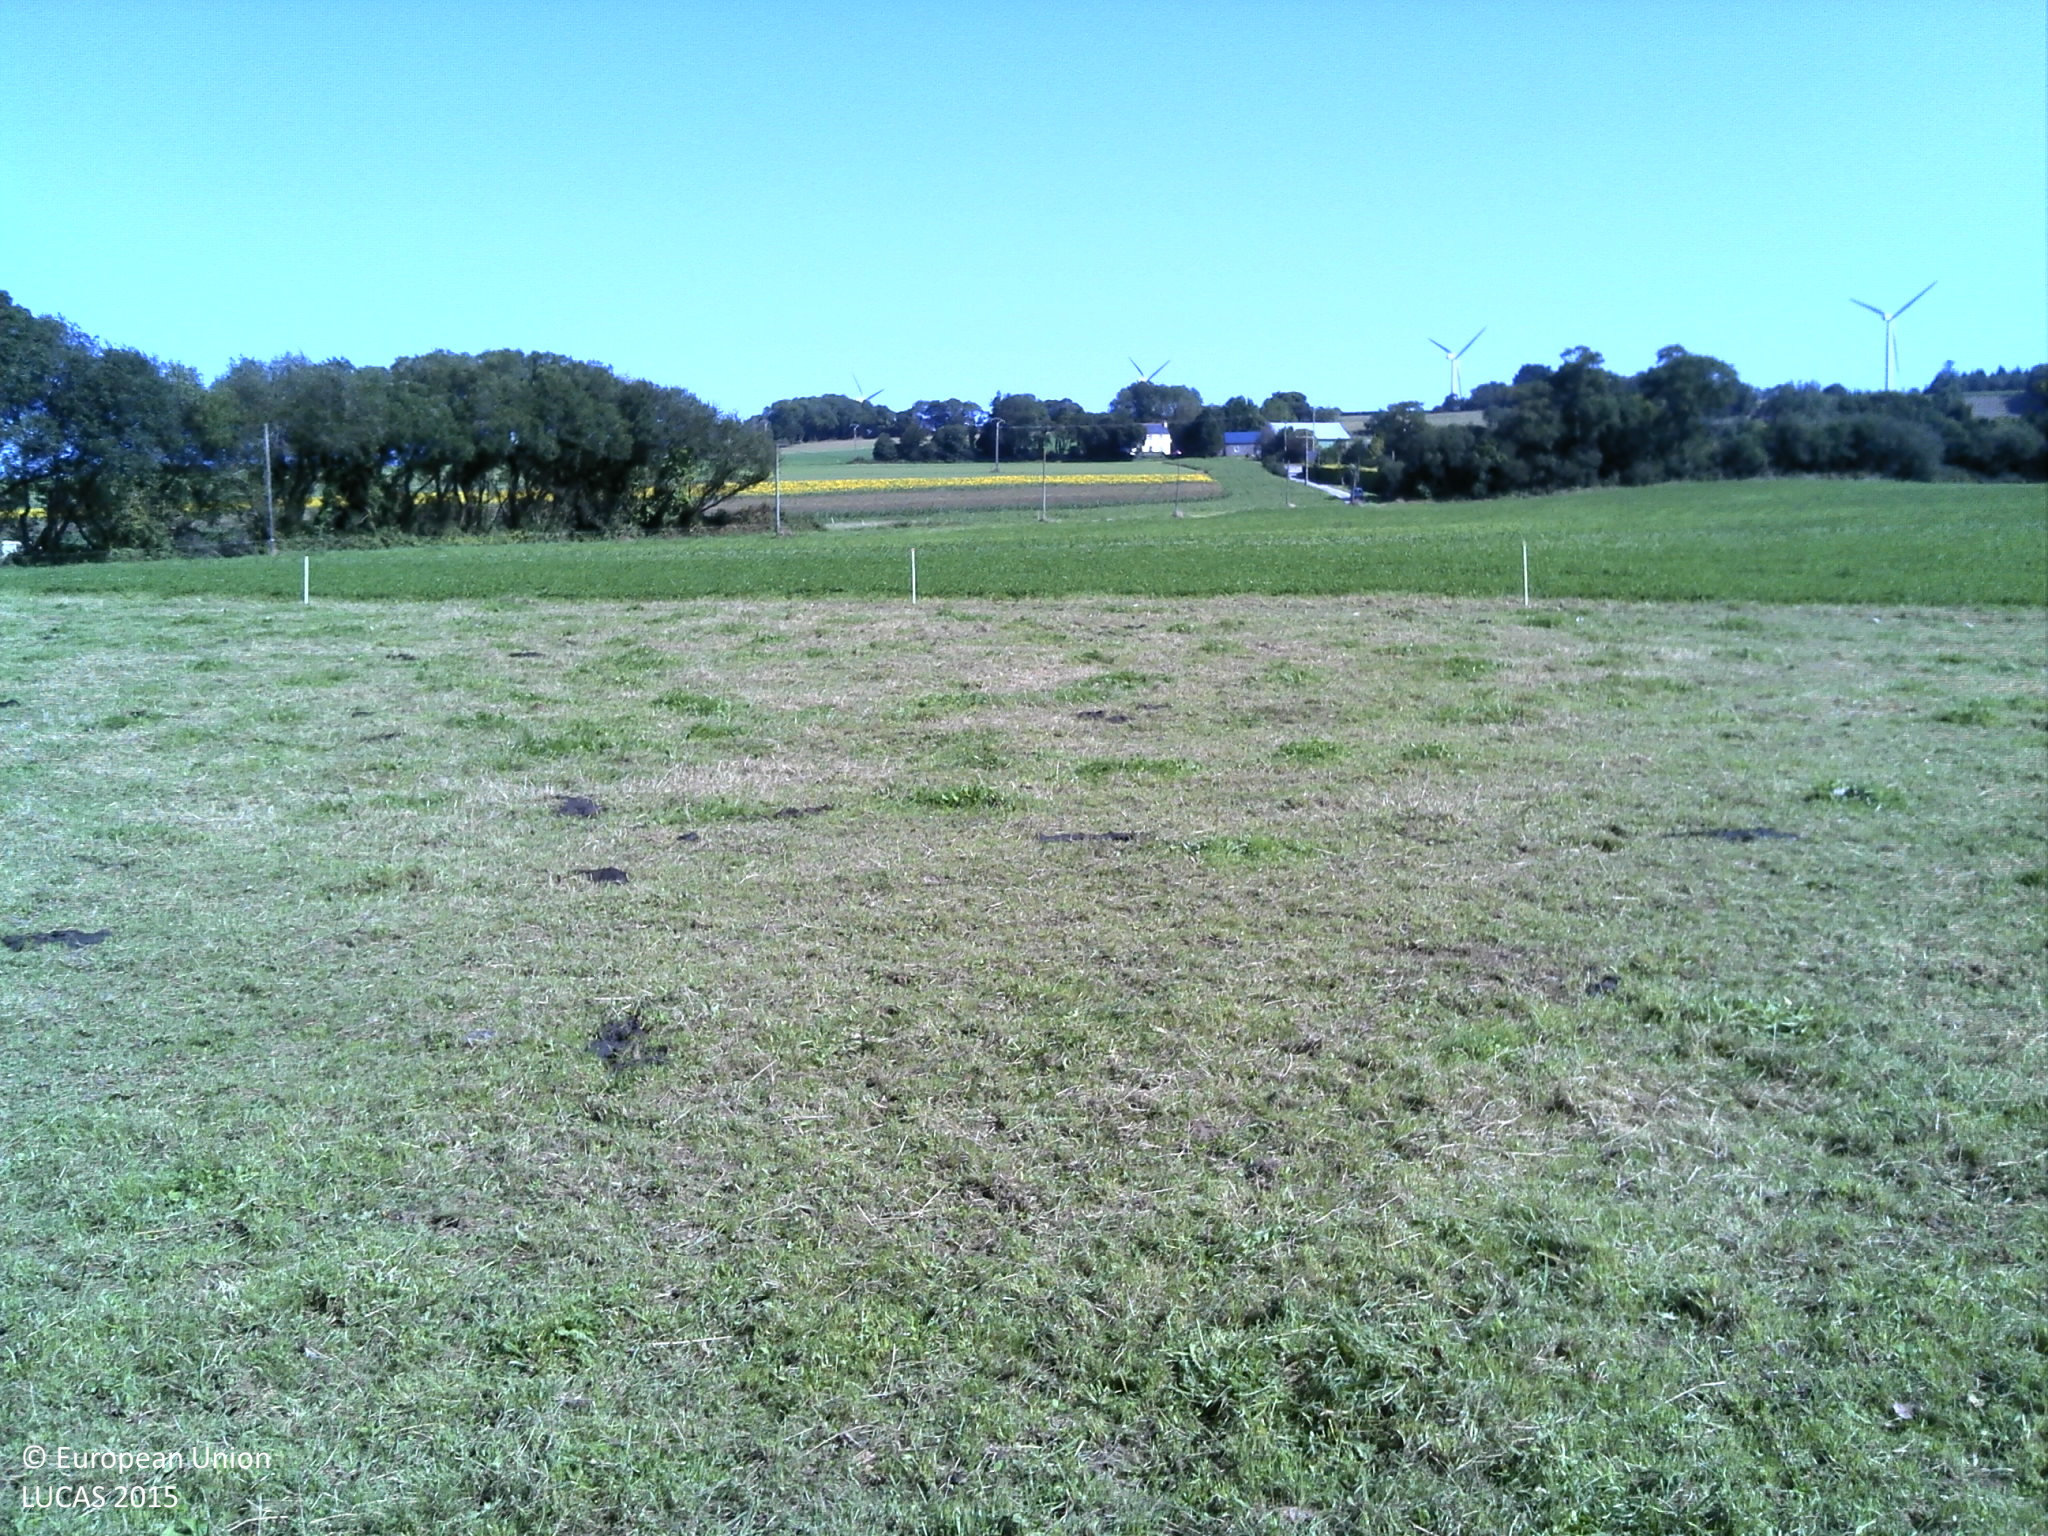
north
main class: Grassland
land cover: Grassland without tree/shrub cover
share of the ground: > 75 %
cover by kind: herbaceous plants 100 %
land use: Agriculture (excluding fallow land and kitchen gardens)
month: September
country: FR
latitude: 48.1648
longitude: -4.1403
